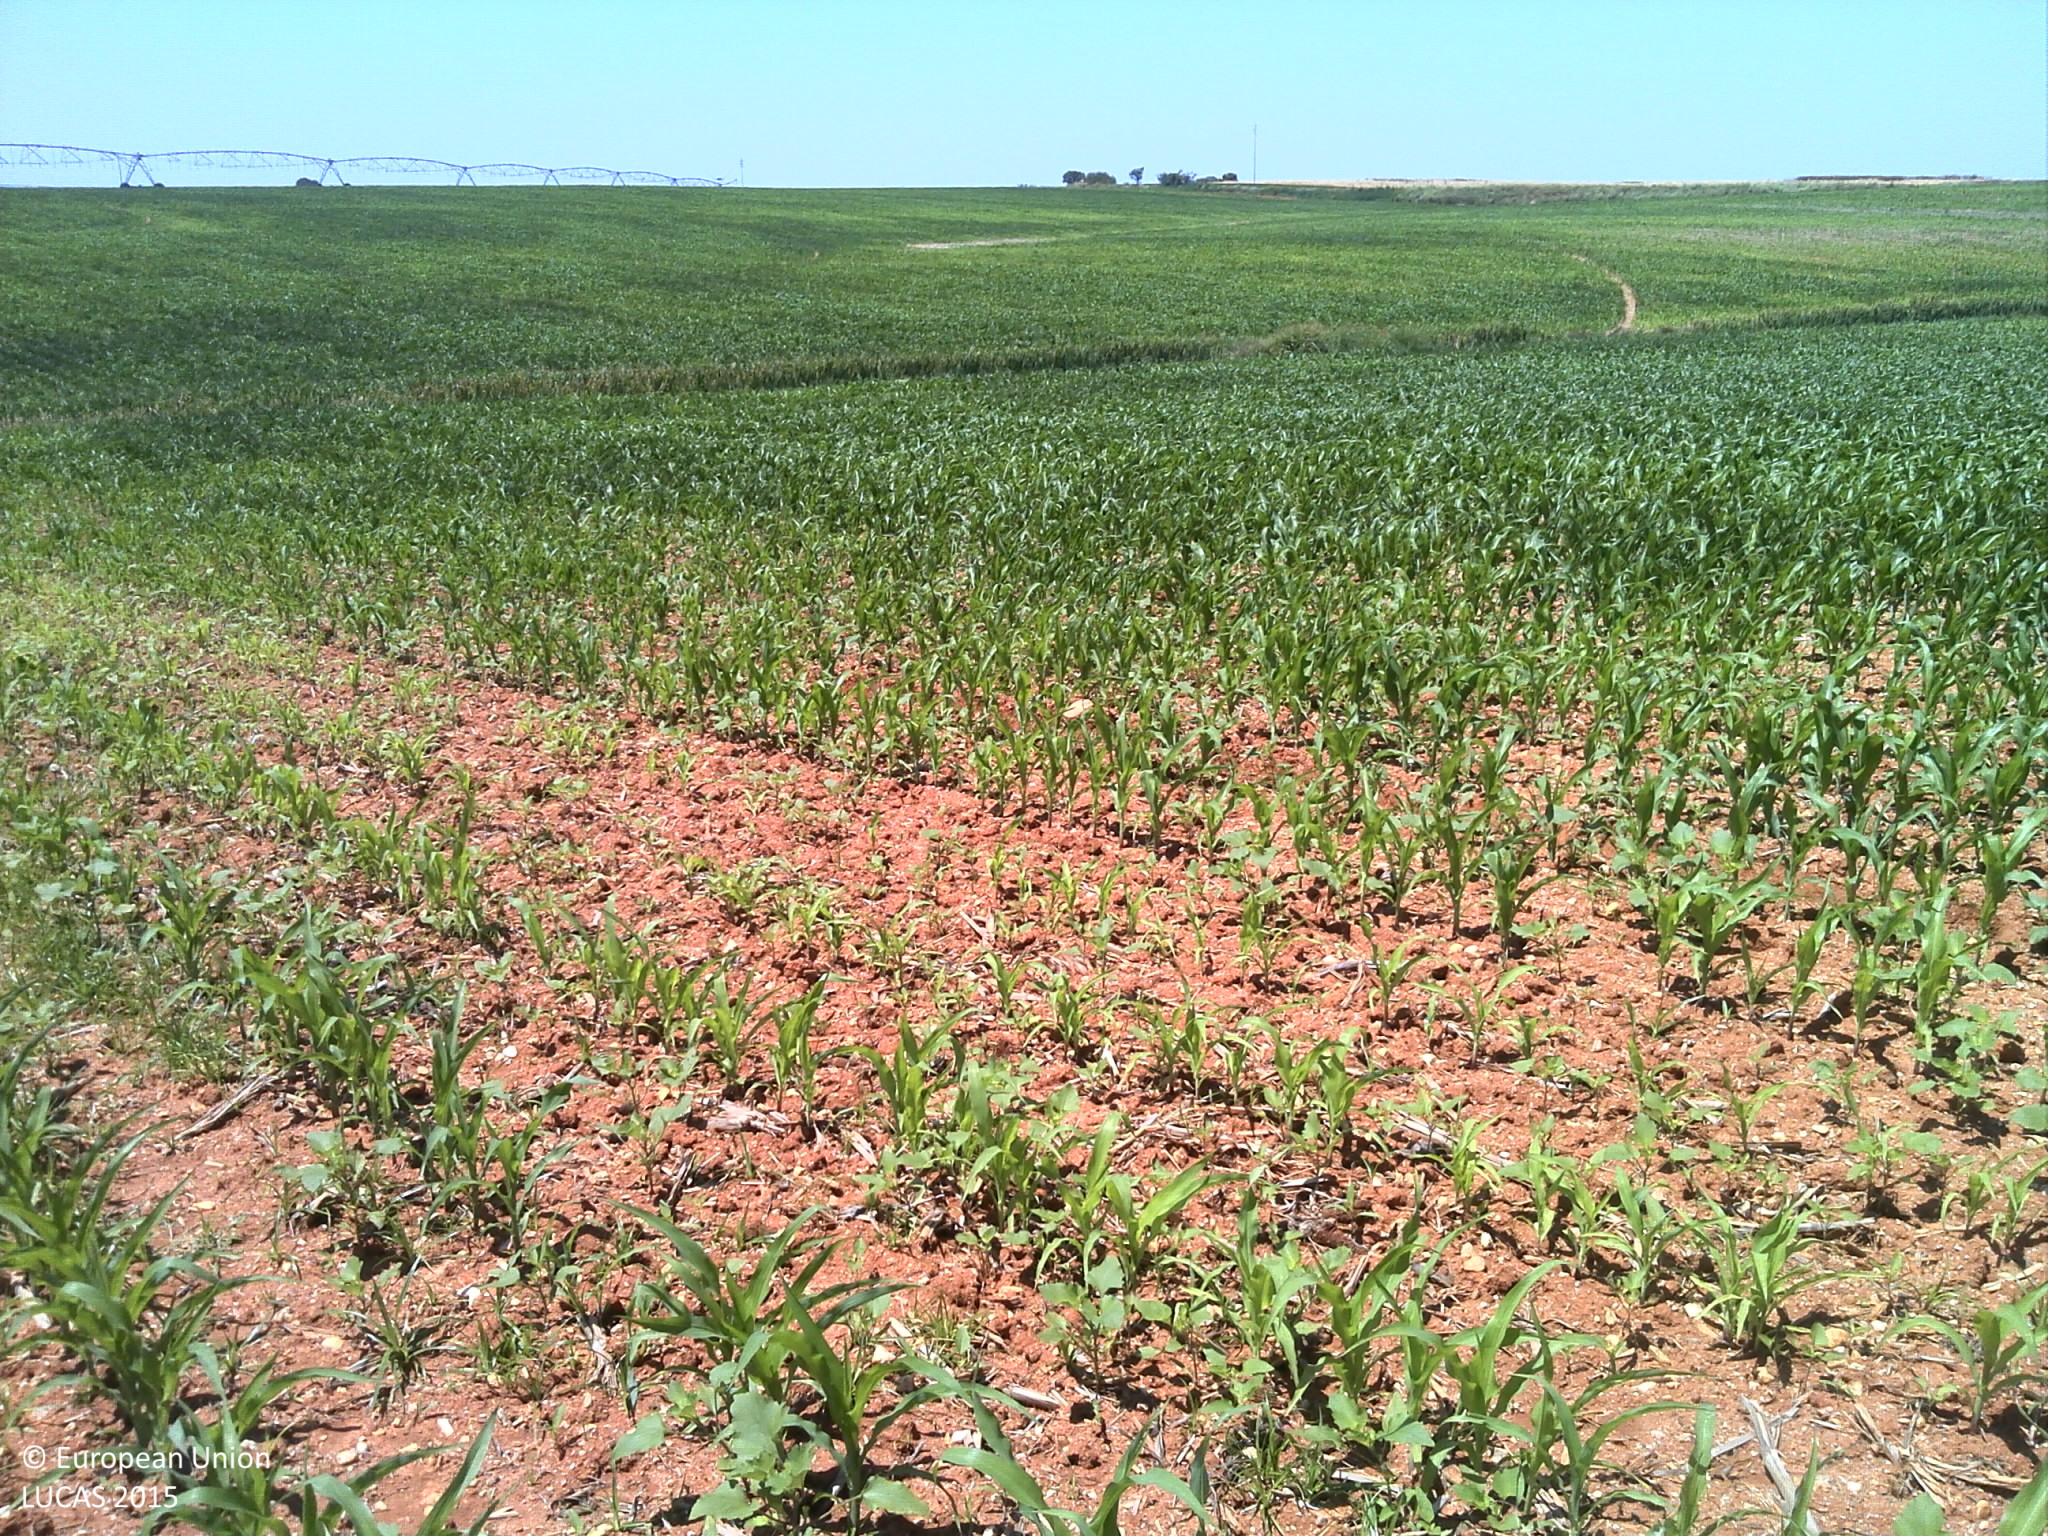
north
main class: Cropland
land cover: Maize
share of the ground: 10 - 25 %
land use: Agriculture (excluding fallow land and kitchen gardens)
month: June
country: PT
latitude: 37.9113
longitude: -8.3382
